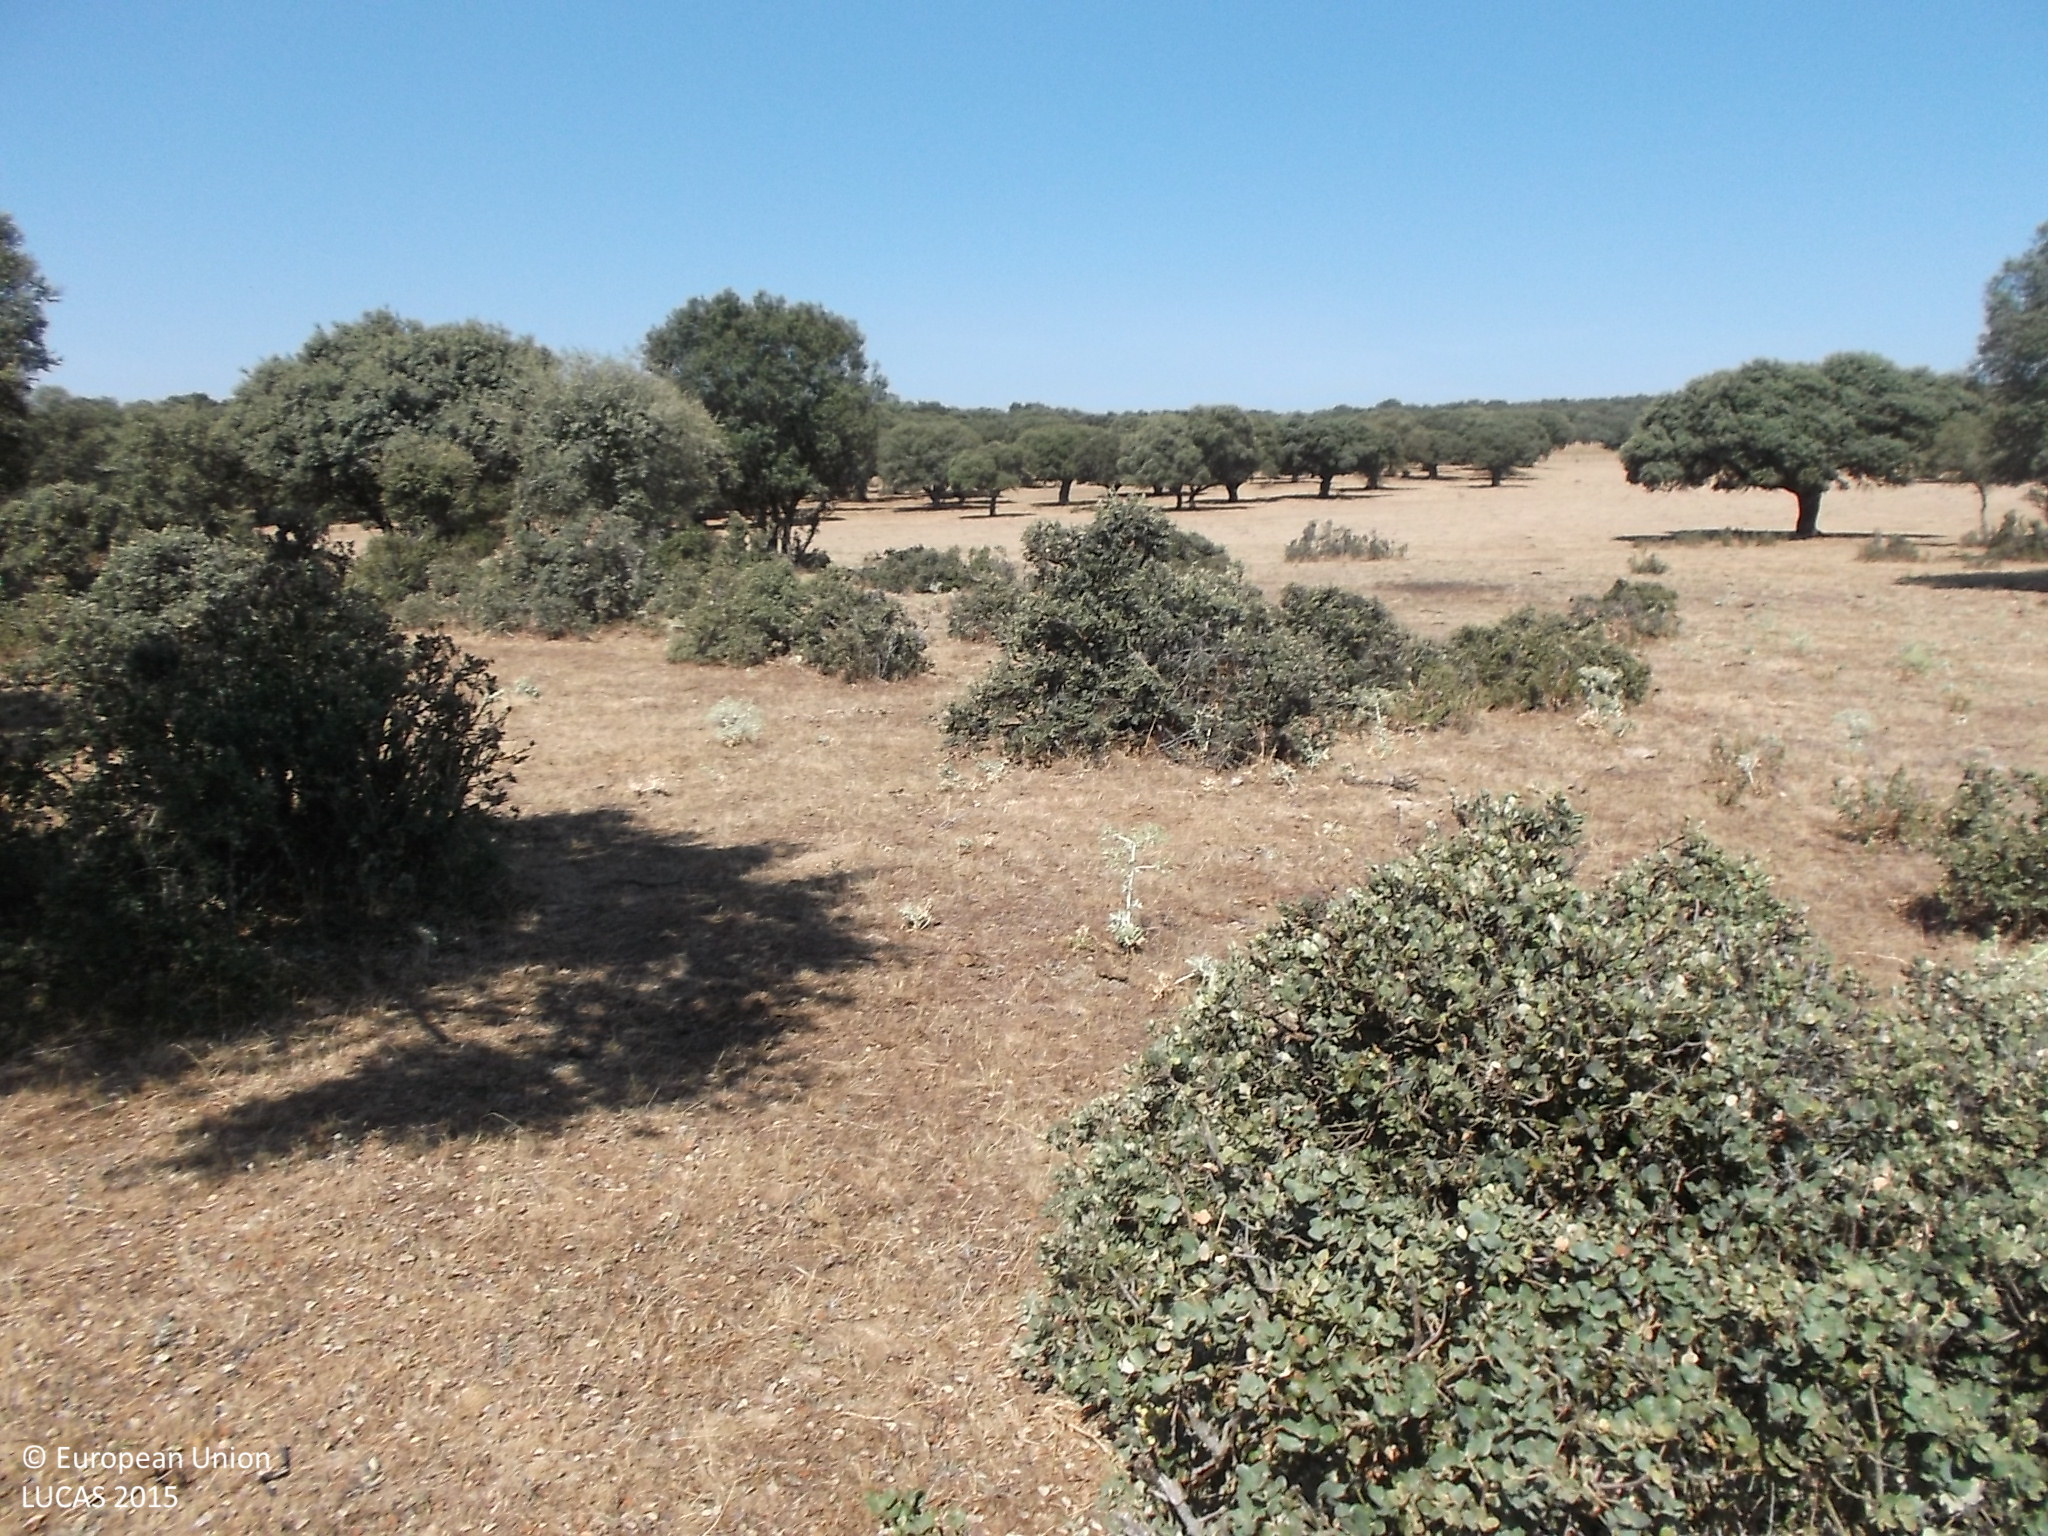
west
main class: Woodland
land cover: Broadleaved woodland
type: broadleaved evergreen forest
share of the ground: 25 - 50 %
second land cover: Shrubland without tree cover
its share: 50 - 75 %
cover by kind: herbaceous plants 40 %, broadleaved forest trees 30 %, shrubs 30 %
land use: Forestry
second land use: Agriculture (excluding fallow land and kitchen gardens)
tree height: < 5 m
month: July
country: ES
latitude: 41.1957
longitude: -5.9571
